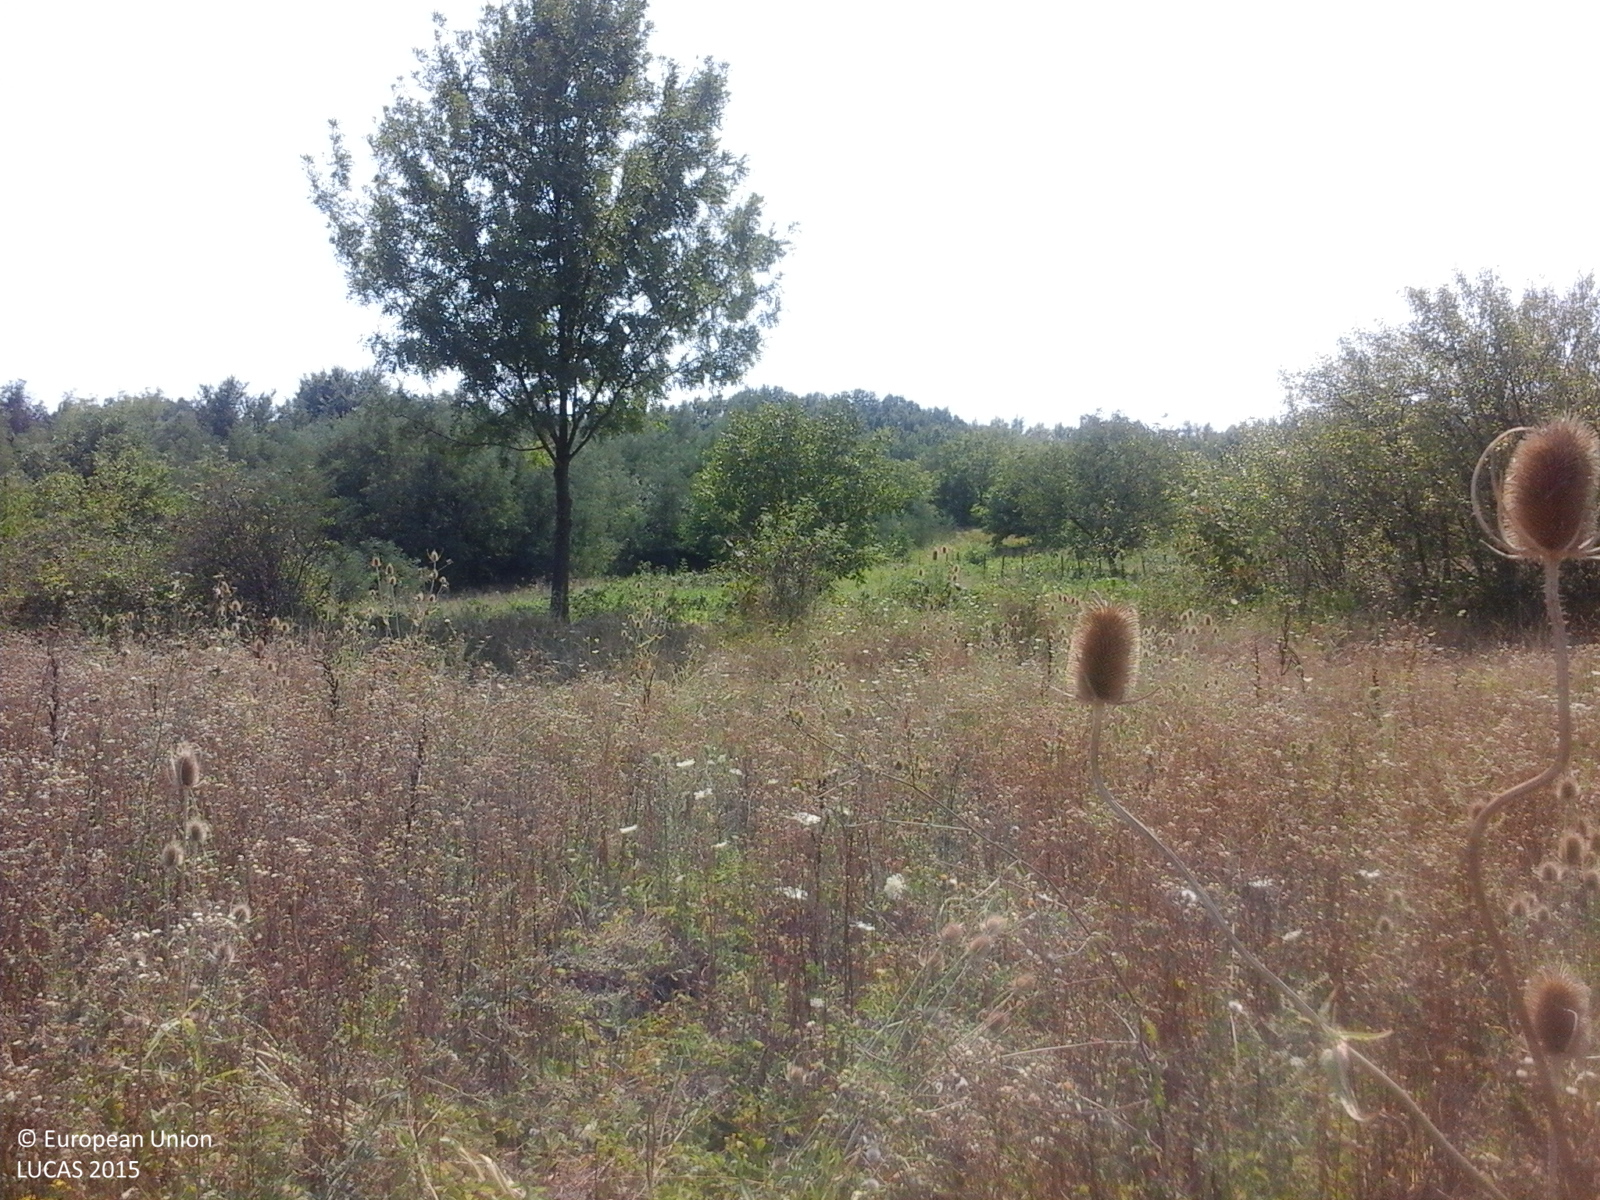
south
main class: Grassland
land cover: Spontaneously vegetated surfaces
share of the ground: > 75 %
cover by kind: herbaceous plants 100 %
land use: Fallow land
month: August
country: RO
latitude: 44.3971
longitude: 23.3456
